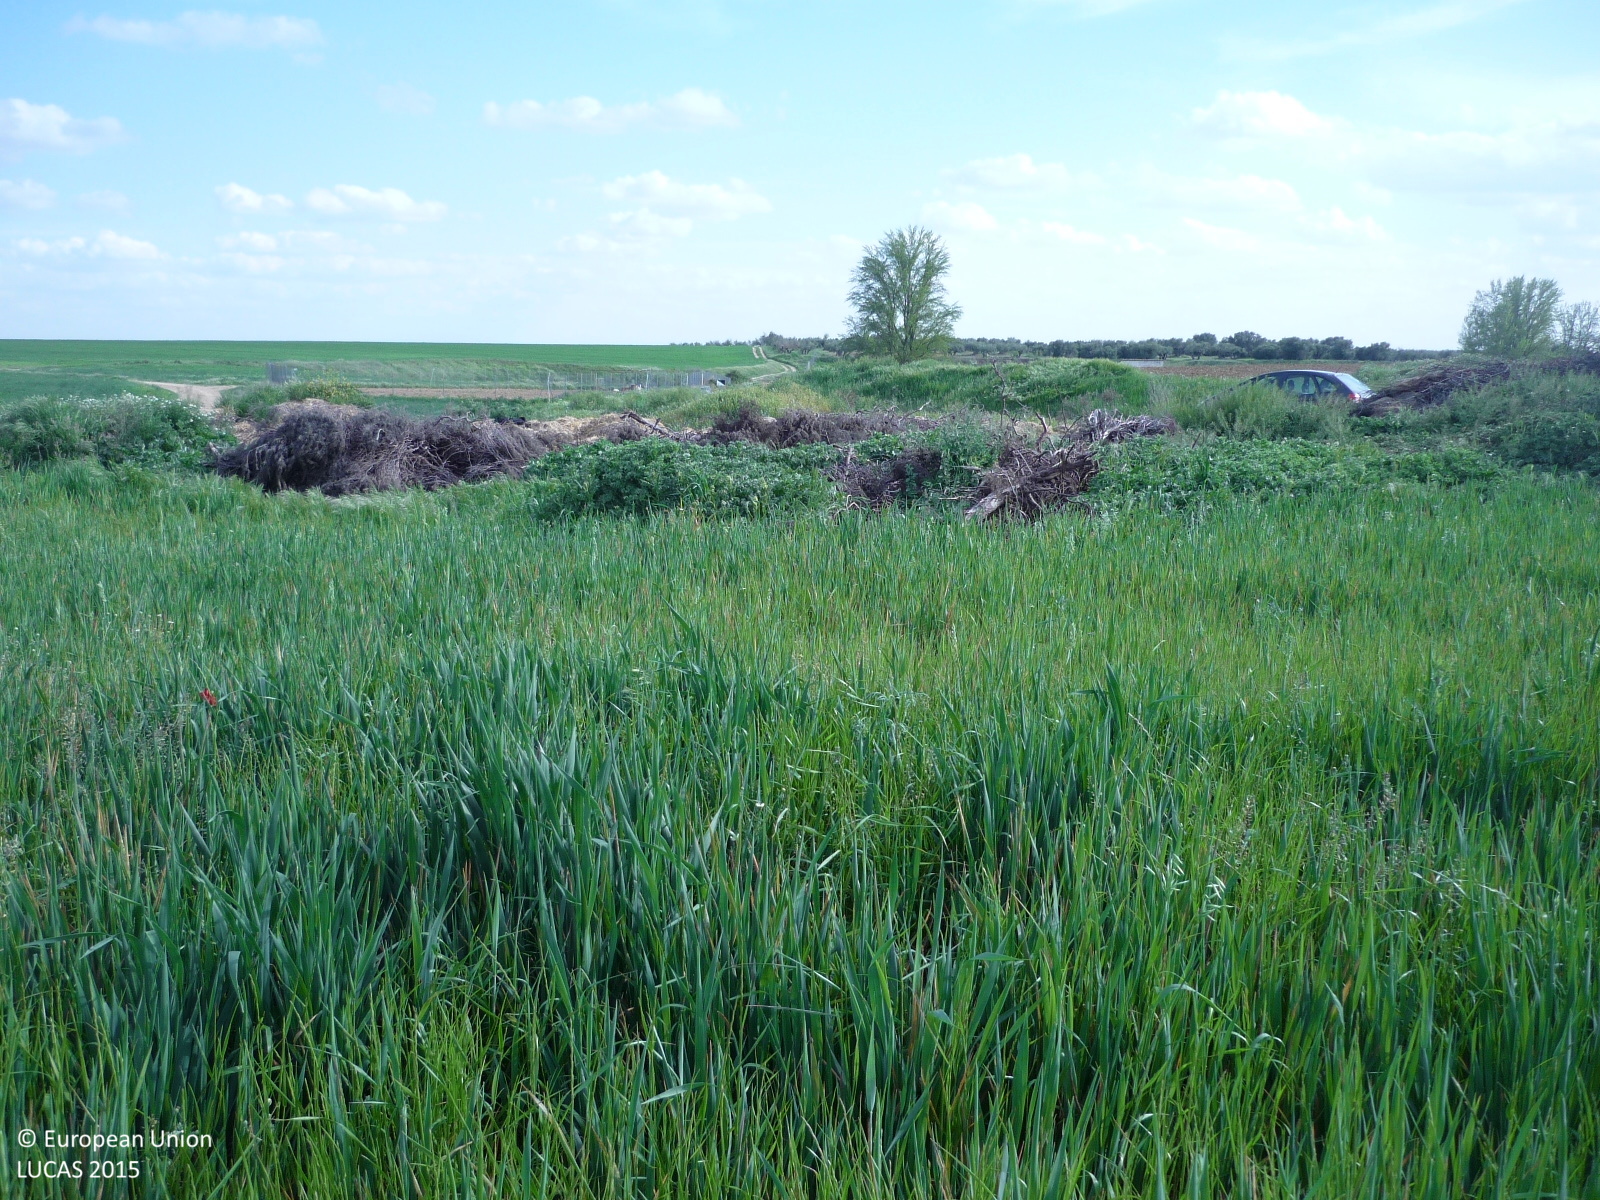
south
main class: Cropland
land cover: Oats
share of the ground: > 75 %
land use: Agriculture (excluding fallow land and kitchen gardens)
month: April
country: ES
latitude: 40.7390
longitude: -3.5032
